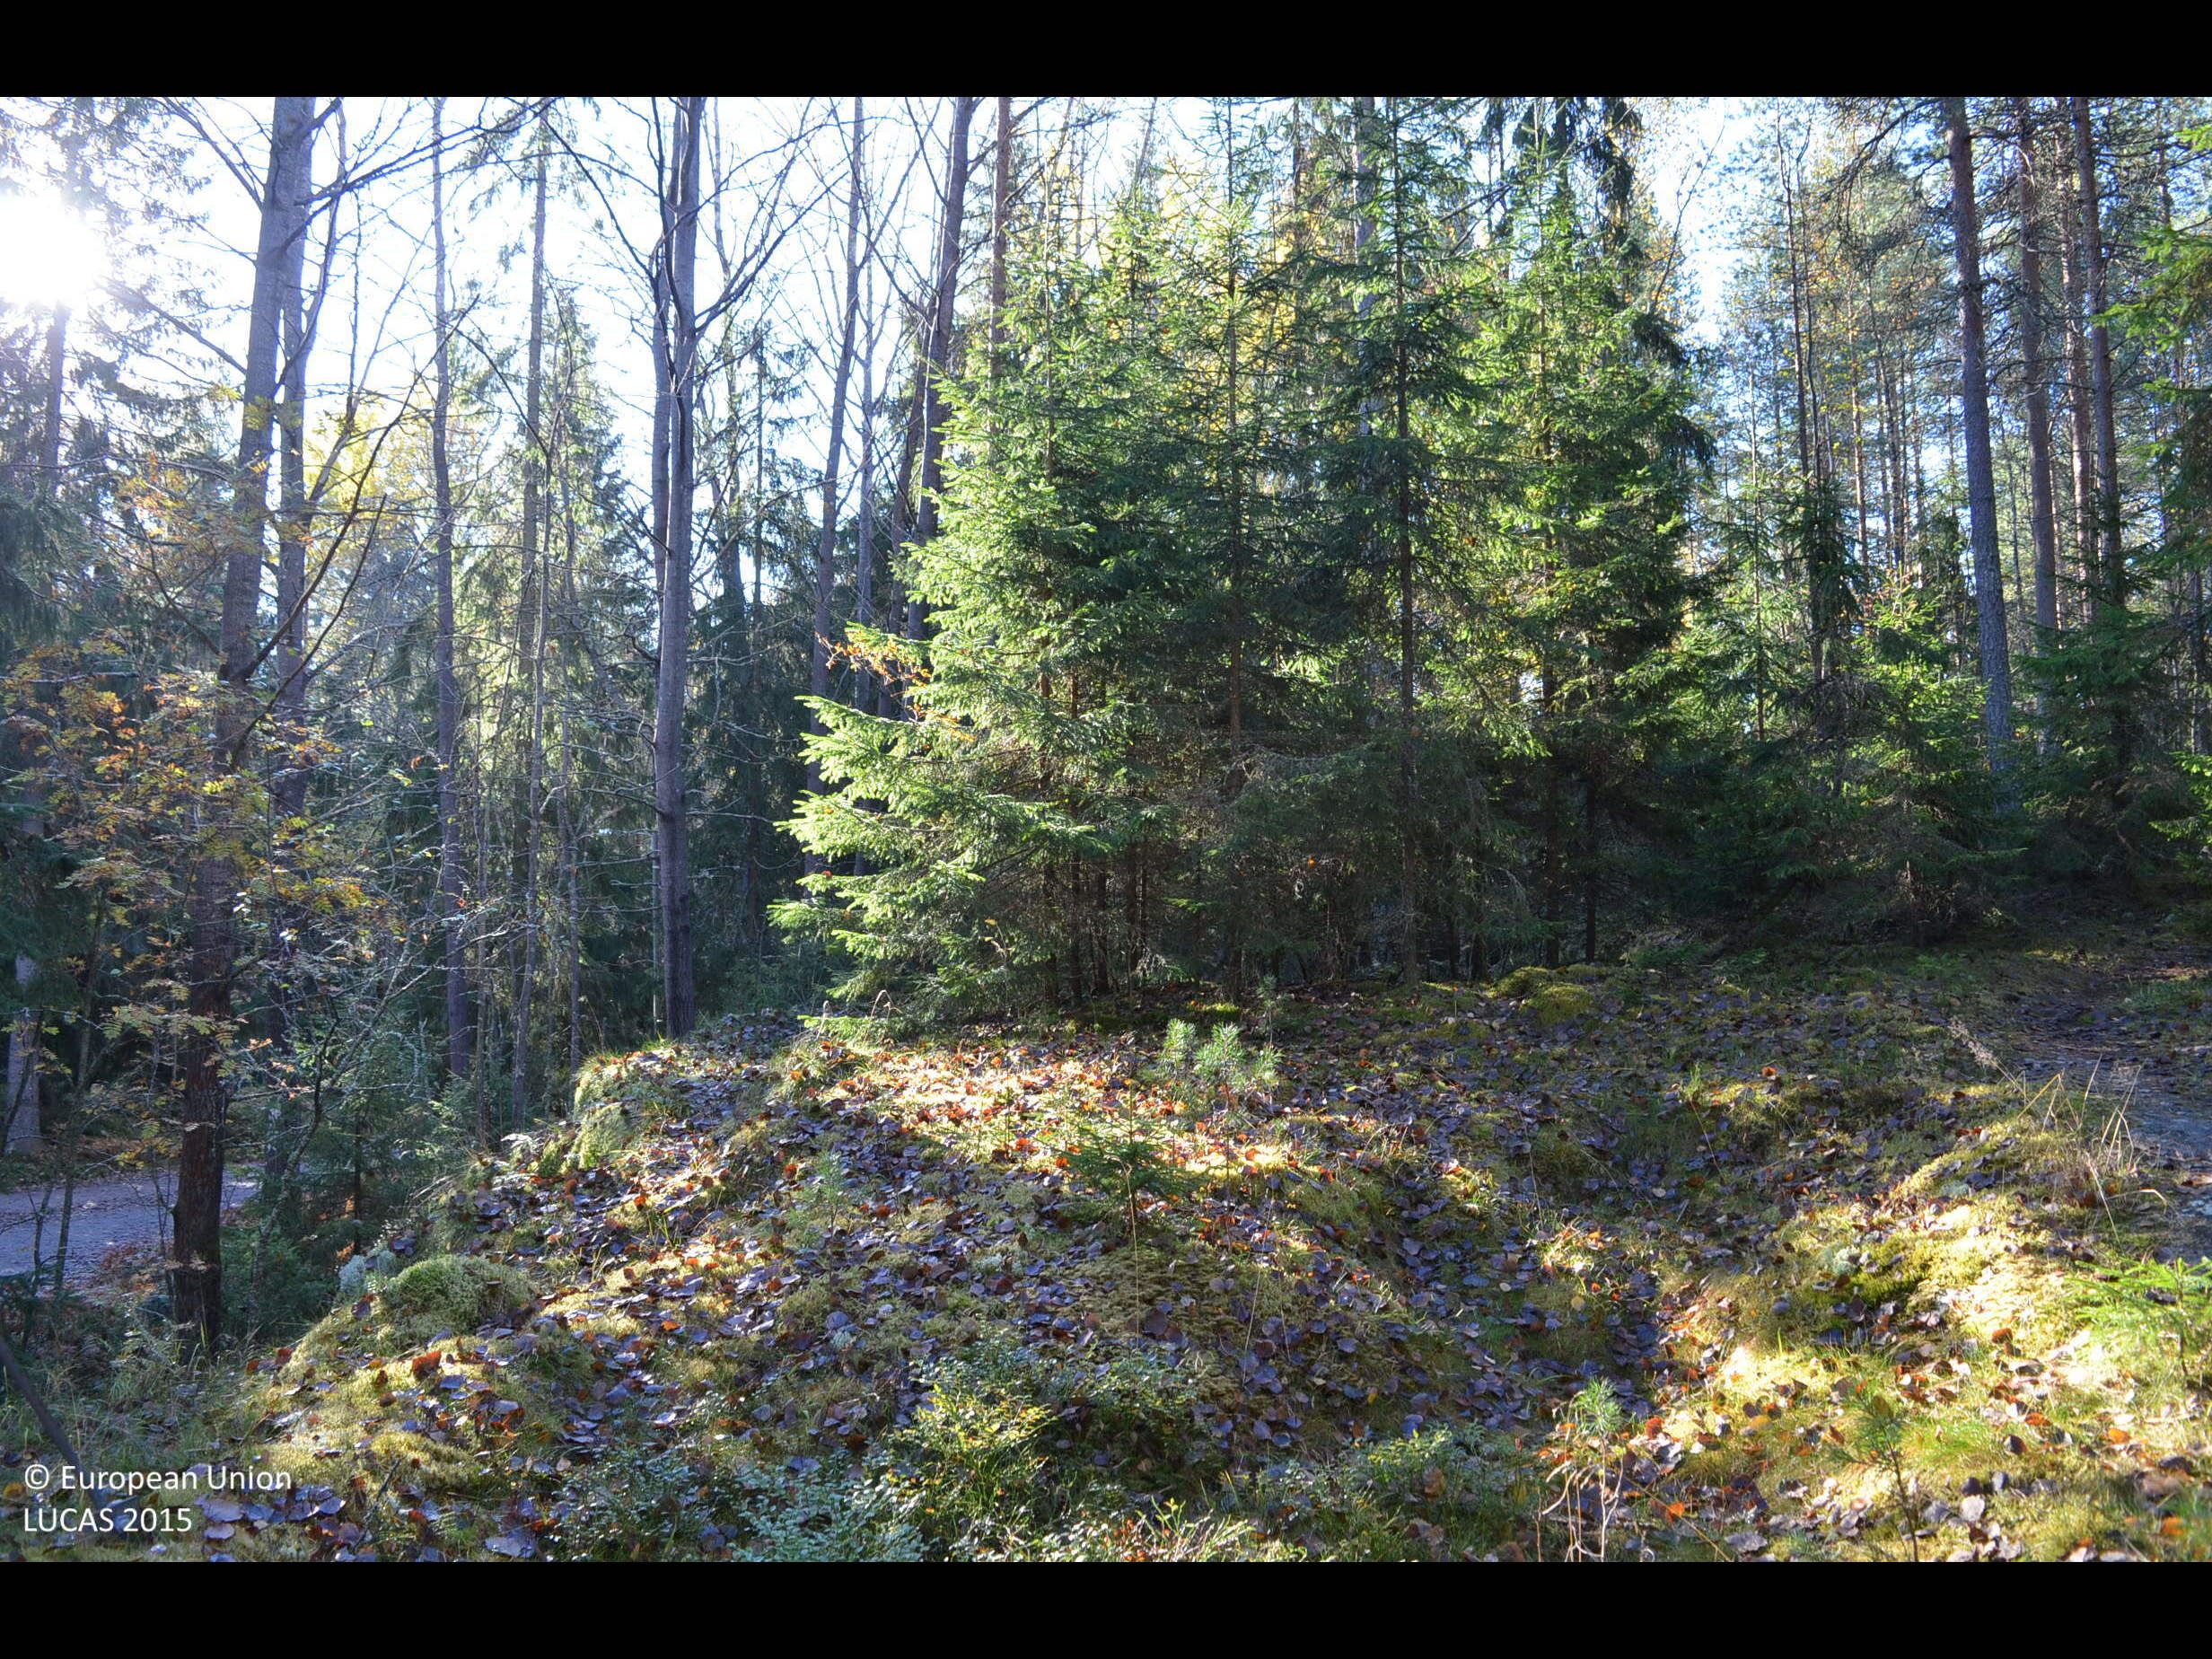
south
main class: Woodland
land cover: Other mixed woodland
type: boreal forest
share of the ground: 50 - 75 %
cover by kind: coniferous forest trees 40 %, broadleaved forest trees 30 %, shrubs 15 %, lichens and mosses 10 %
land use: Amenities, museums, leisure
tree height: > 5 m
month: October
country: FI
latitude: 61.5118
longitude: 23.8234
